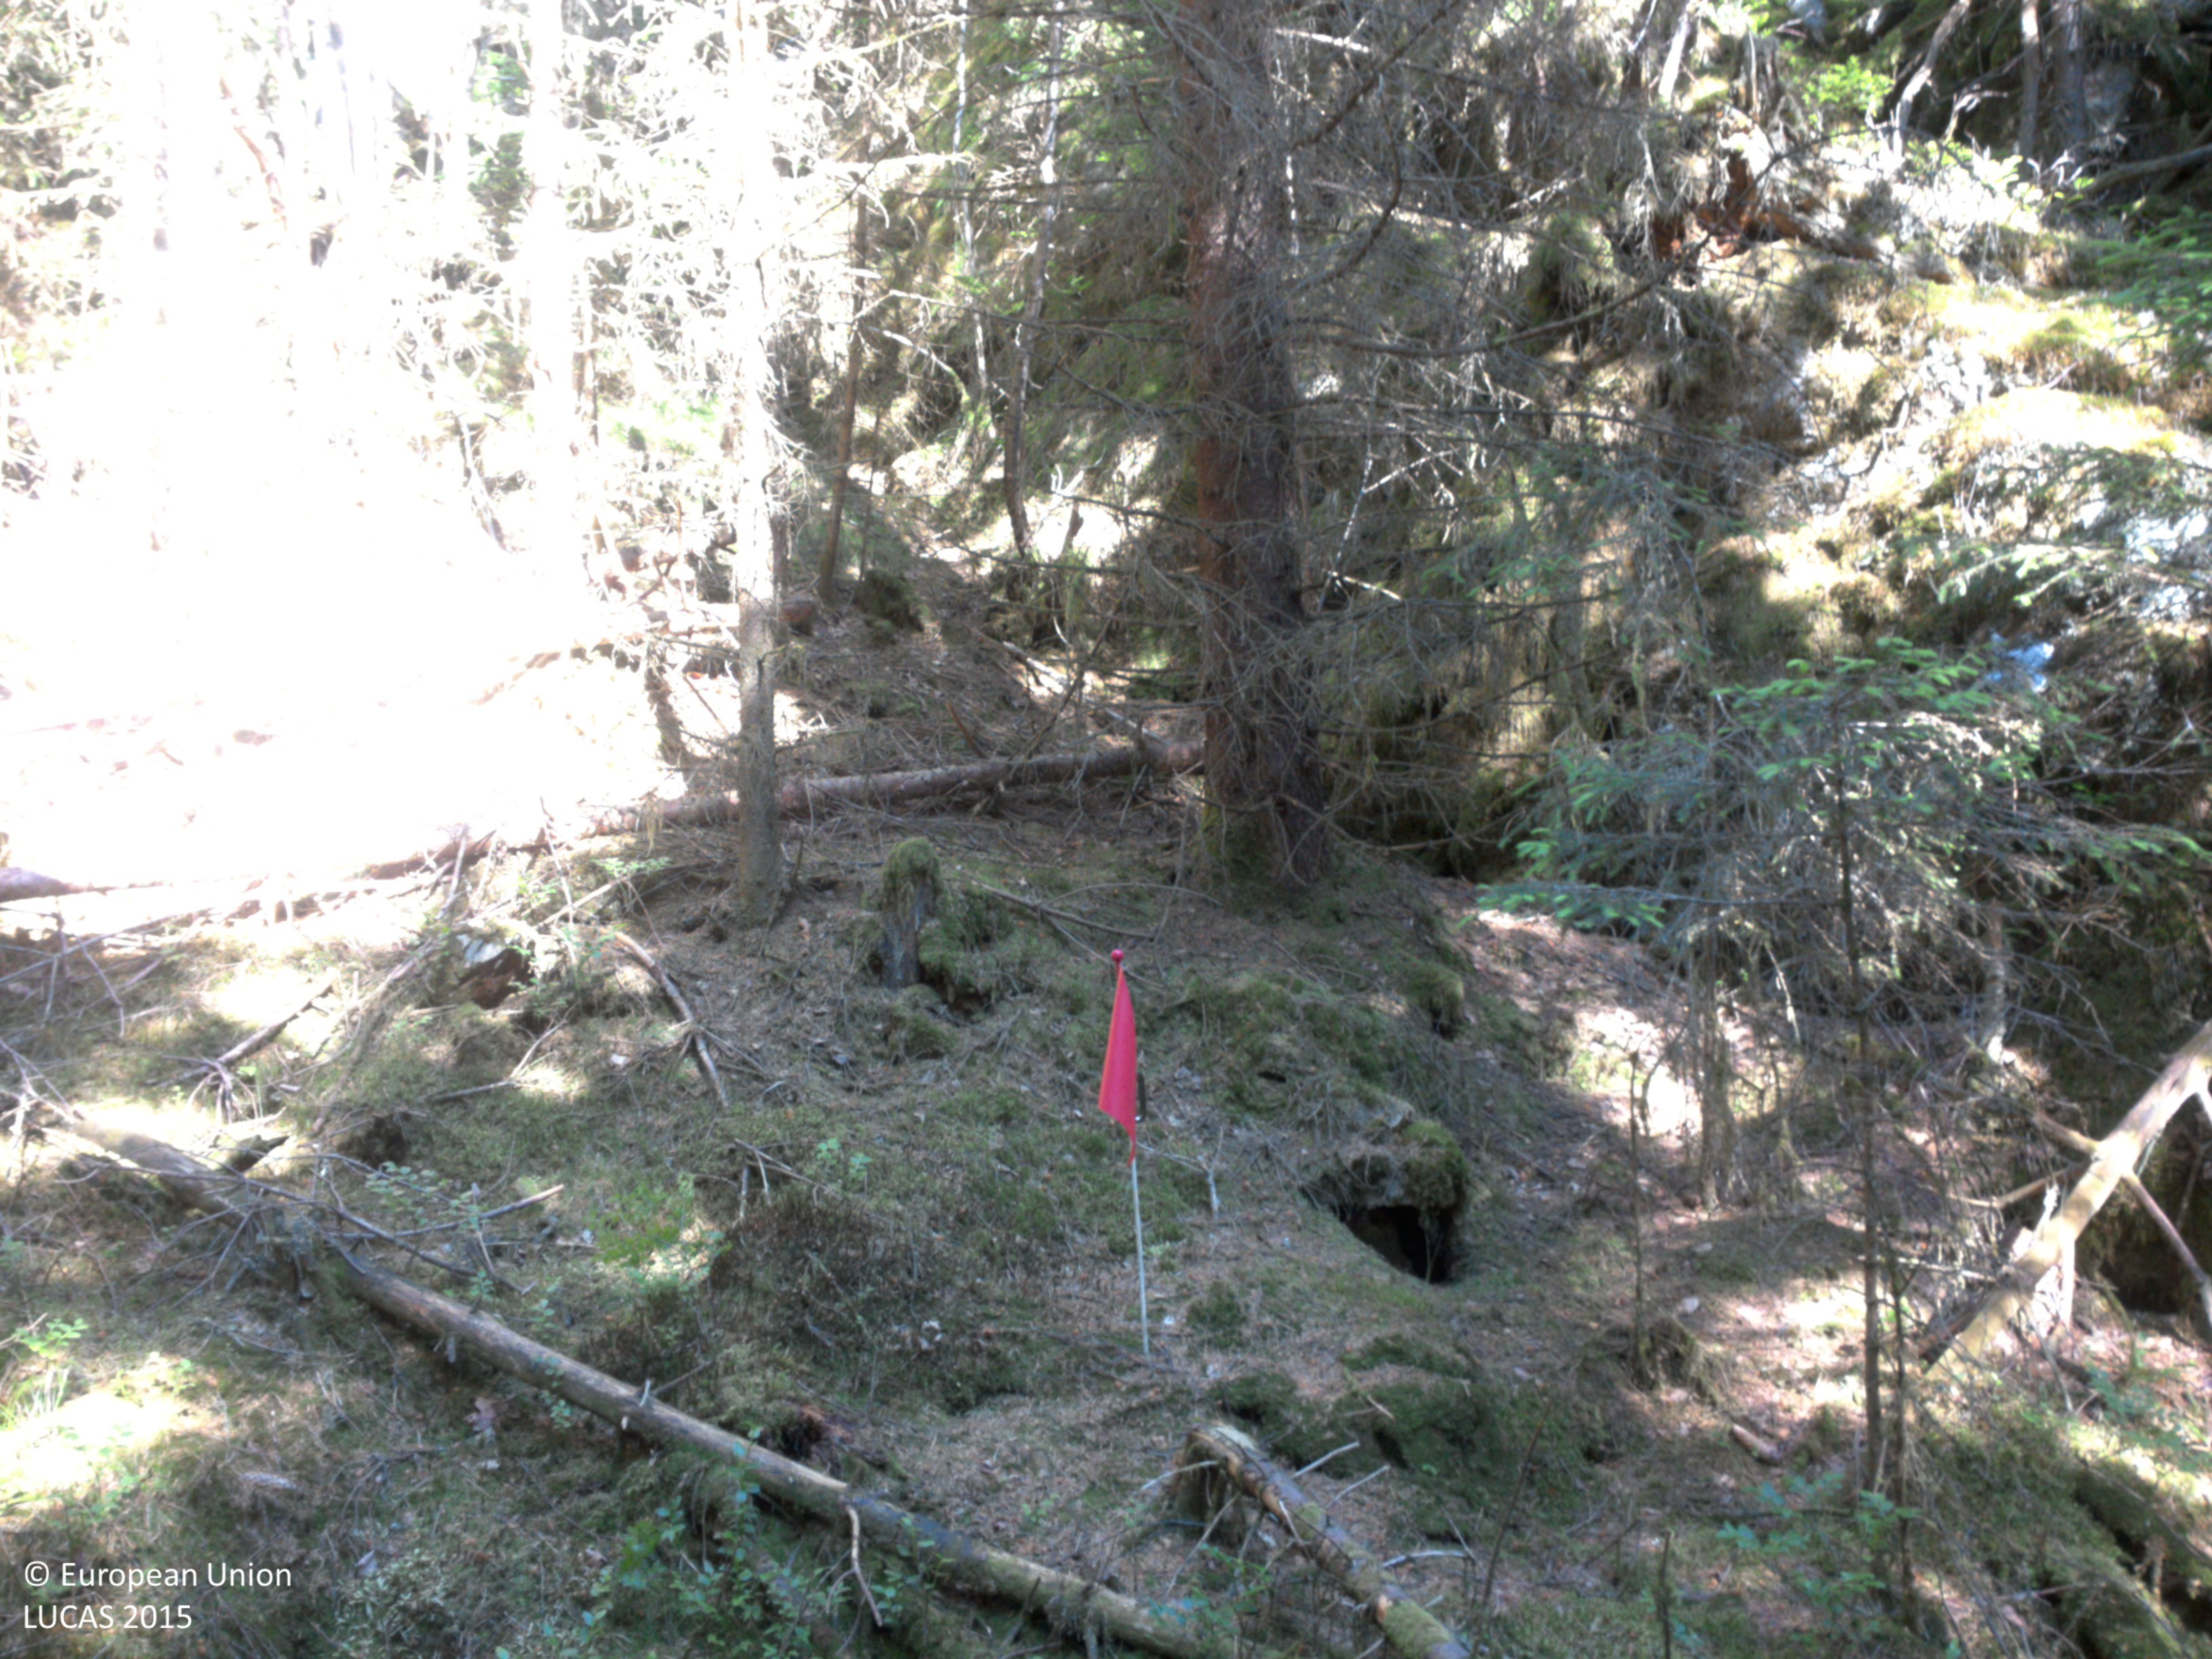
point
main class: Woodland
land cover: Spruce dominated coniferous woodland
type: boreal forest
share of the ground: > 75 %
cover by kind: coniferous forest trees 75 %, lichens and mosses 20 %, broadleaved forest trees 5 %
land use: Forestry
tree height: > 5 m
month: July
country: SE
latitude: 58.4764
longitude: 11.8652
